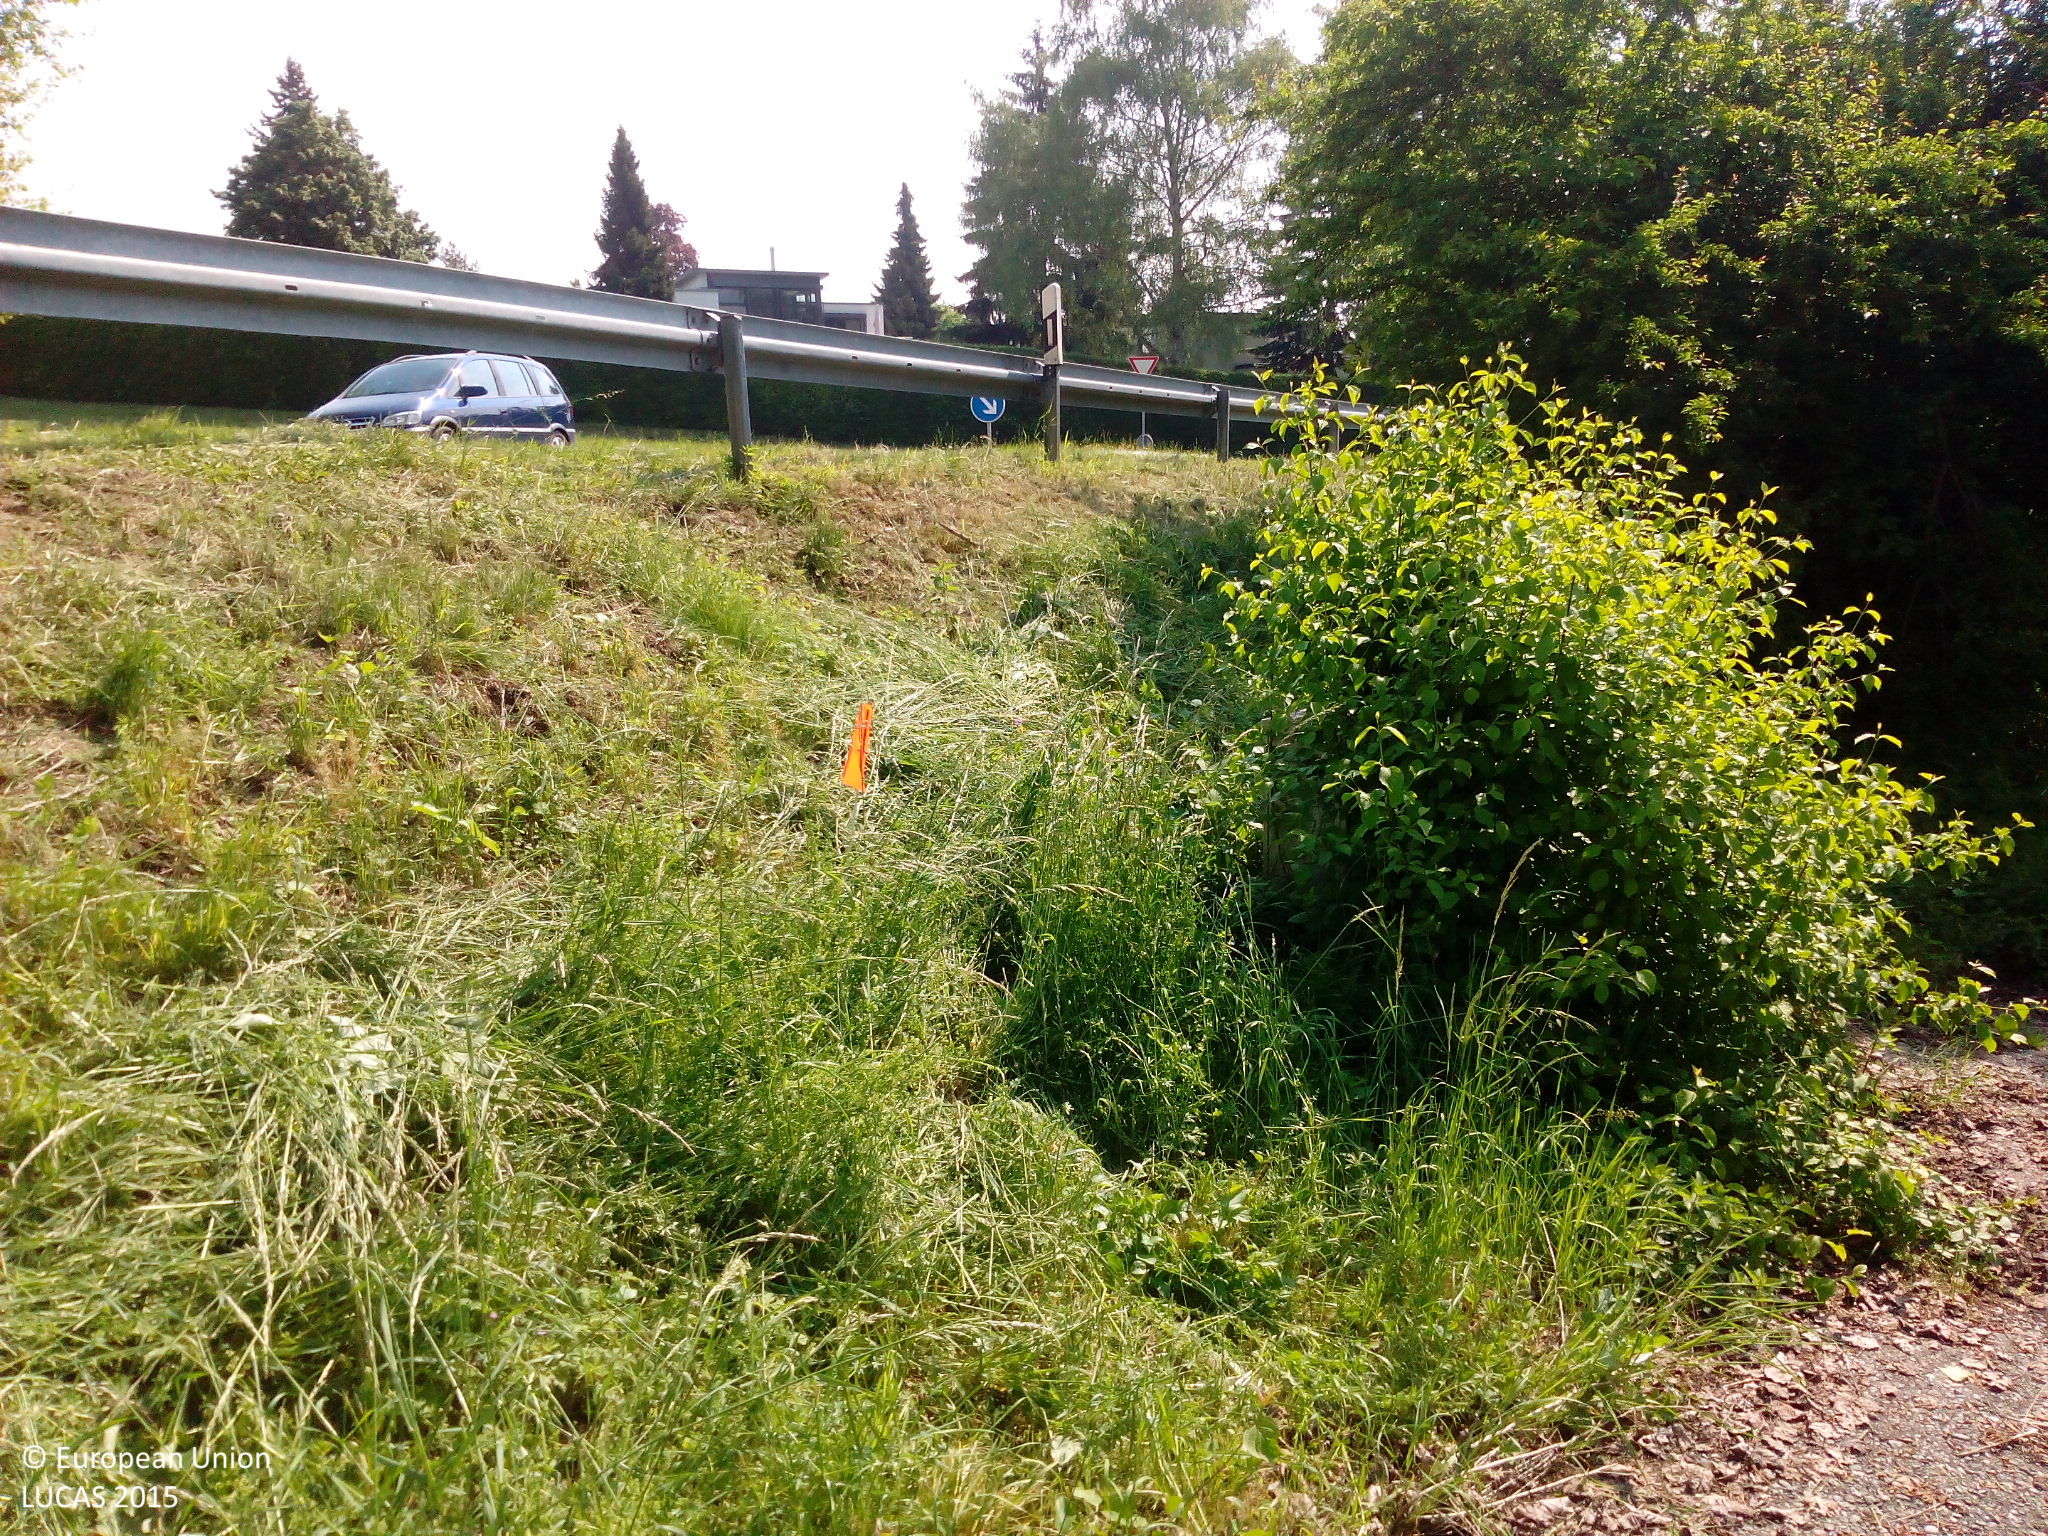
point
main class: Woodland
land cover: Broadleaved woodland
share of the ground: 10 - 25 %
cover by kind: herbaceous plants 80 %, broadleaved forest trees 20 %
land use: Road transport
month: May
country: DE
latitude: 48.2409
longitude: 9.6367
